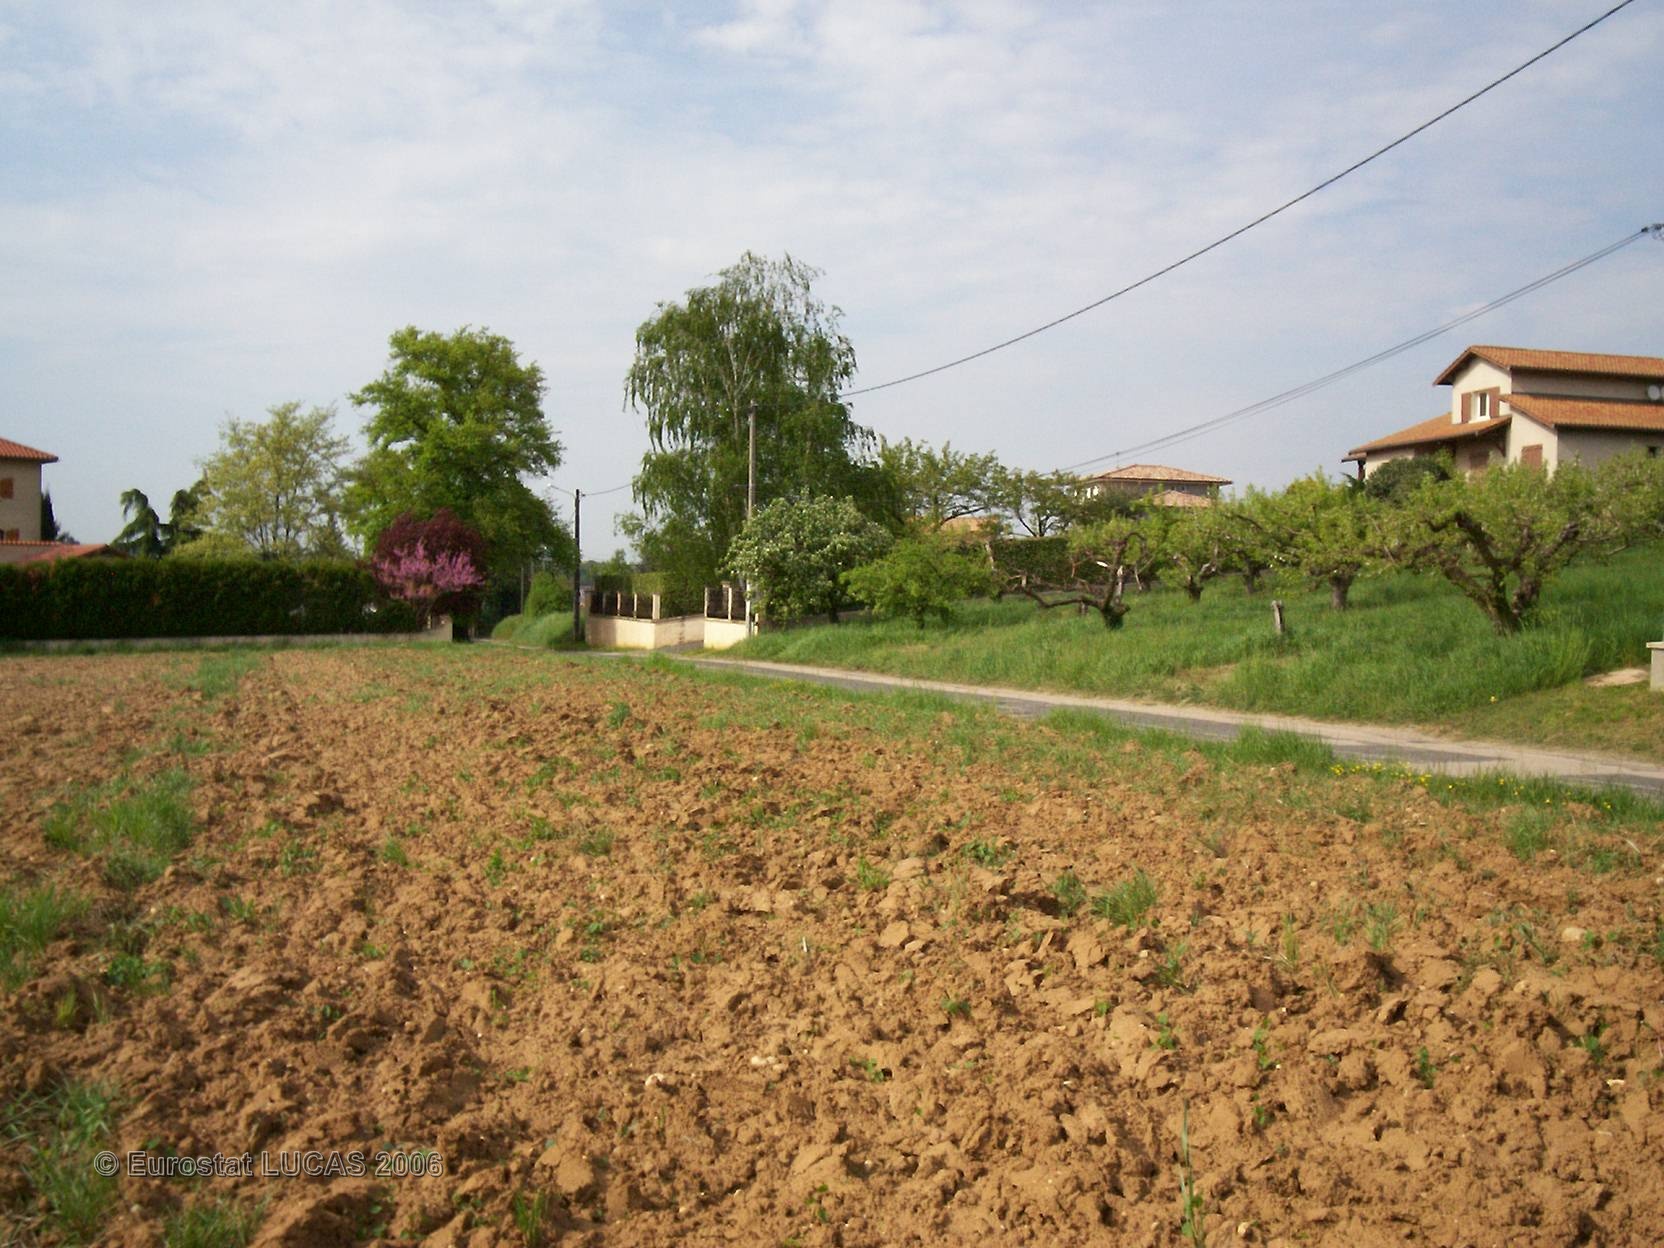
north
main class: Cropland
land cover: Maize
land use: Agriculture (excluding fallow land and kitchen gardens)
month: June
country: FR
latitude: 45.9529
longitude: 4.7779
